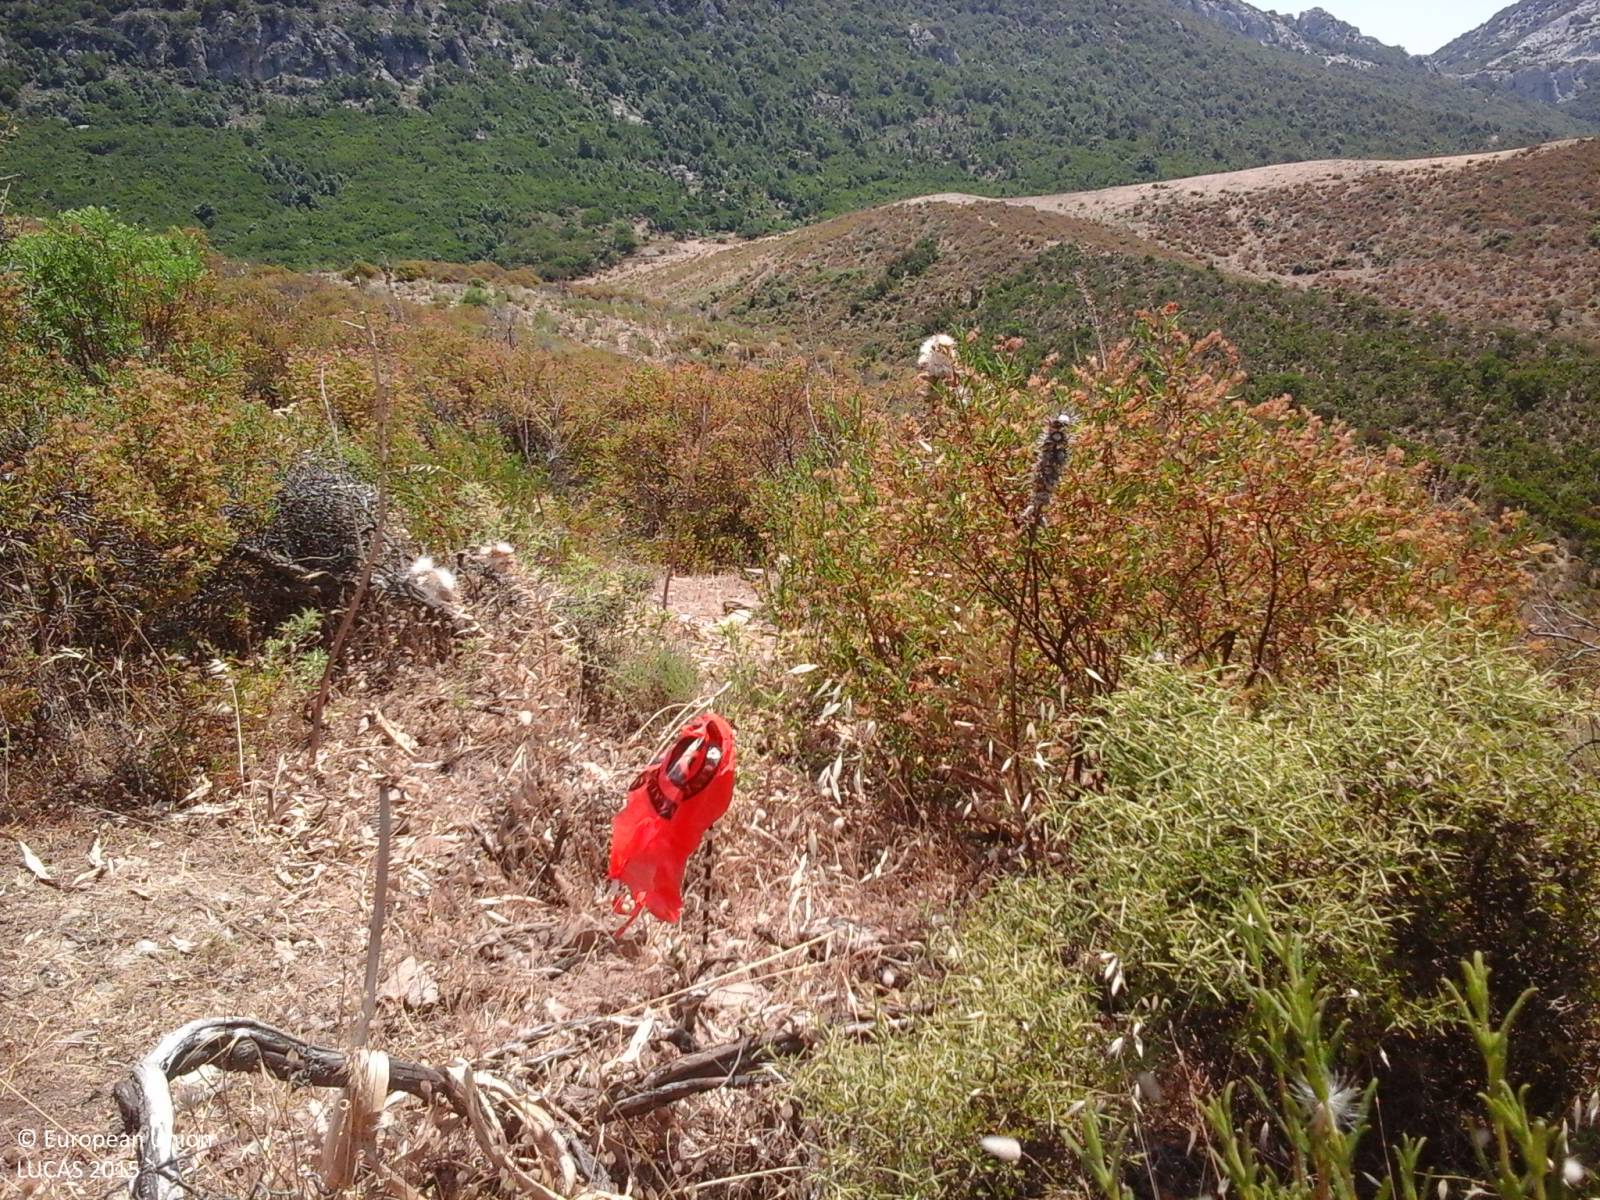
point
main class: Shrubland
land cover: Shrubland without tree cover
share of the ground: > 75 %
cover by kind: shrubs 95 %, herbaceous plants 5 %
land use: Semi-natural and natural areas not in use
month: July
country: IT
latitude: 40.4834
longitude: 9.5188
